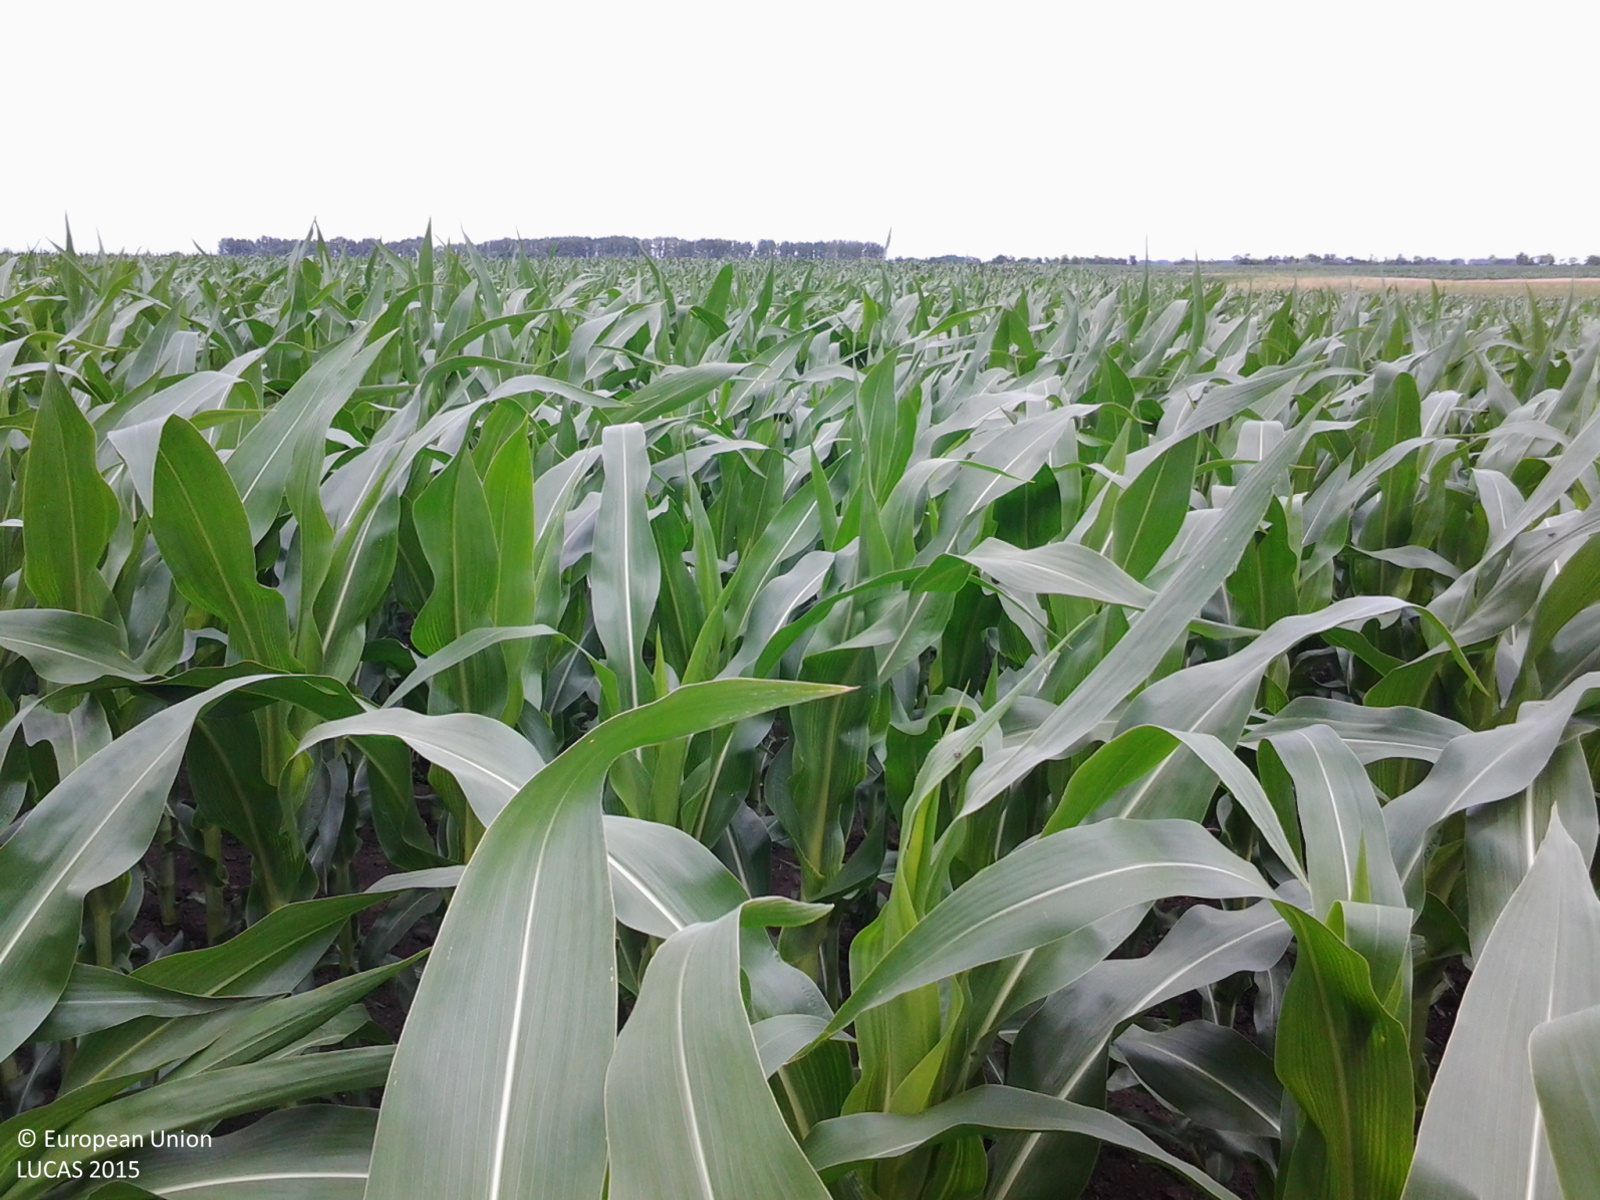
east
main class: Cropland
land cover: Maize
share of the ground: > 75 %
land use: Agriculture (excluding fallow land and kitchen gardens)
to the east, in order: Maize; Barley; Maize
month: June
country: HU
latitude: 46.6479
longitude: 20.7040
